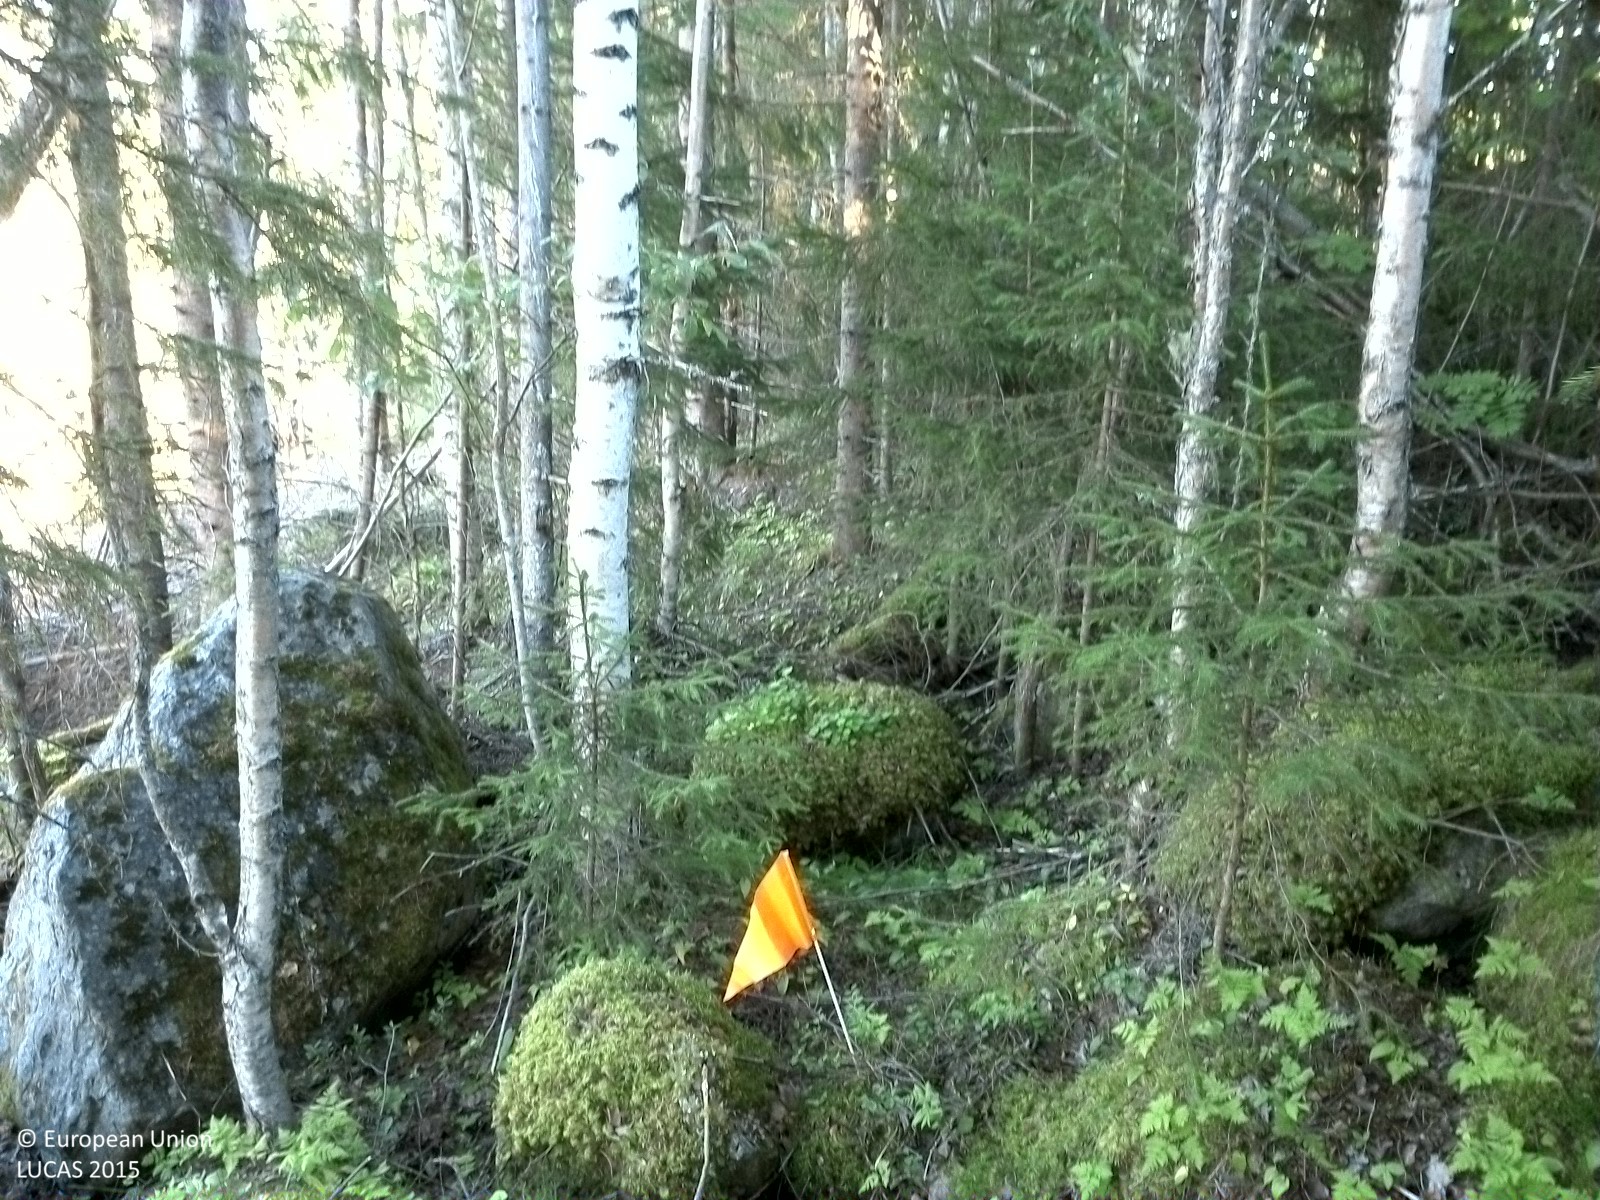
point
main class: Woodland
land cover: Spruce dominated mixed woodland
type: boreal forest
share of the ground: > 75 %
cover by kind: broadleaved forest trees 40 %, coniferous forest trees 35 %, lichens and mosses 15 %, herbaceous plants 10 %
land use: Forestry
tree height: > 5 m
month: August
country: SE
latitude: 62.3850
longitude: 16.4194
